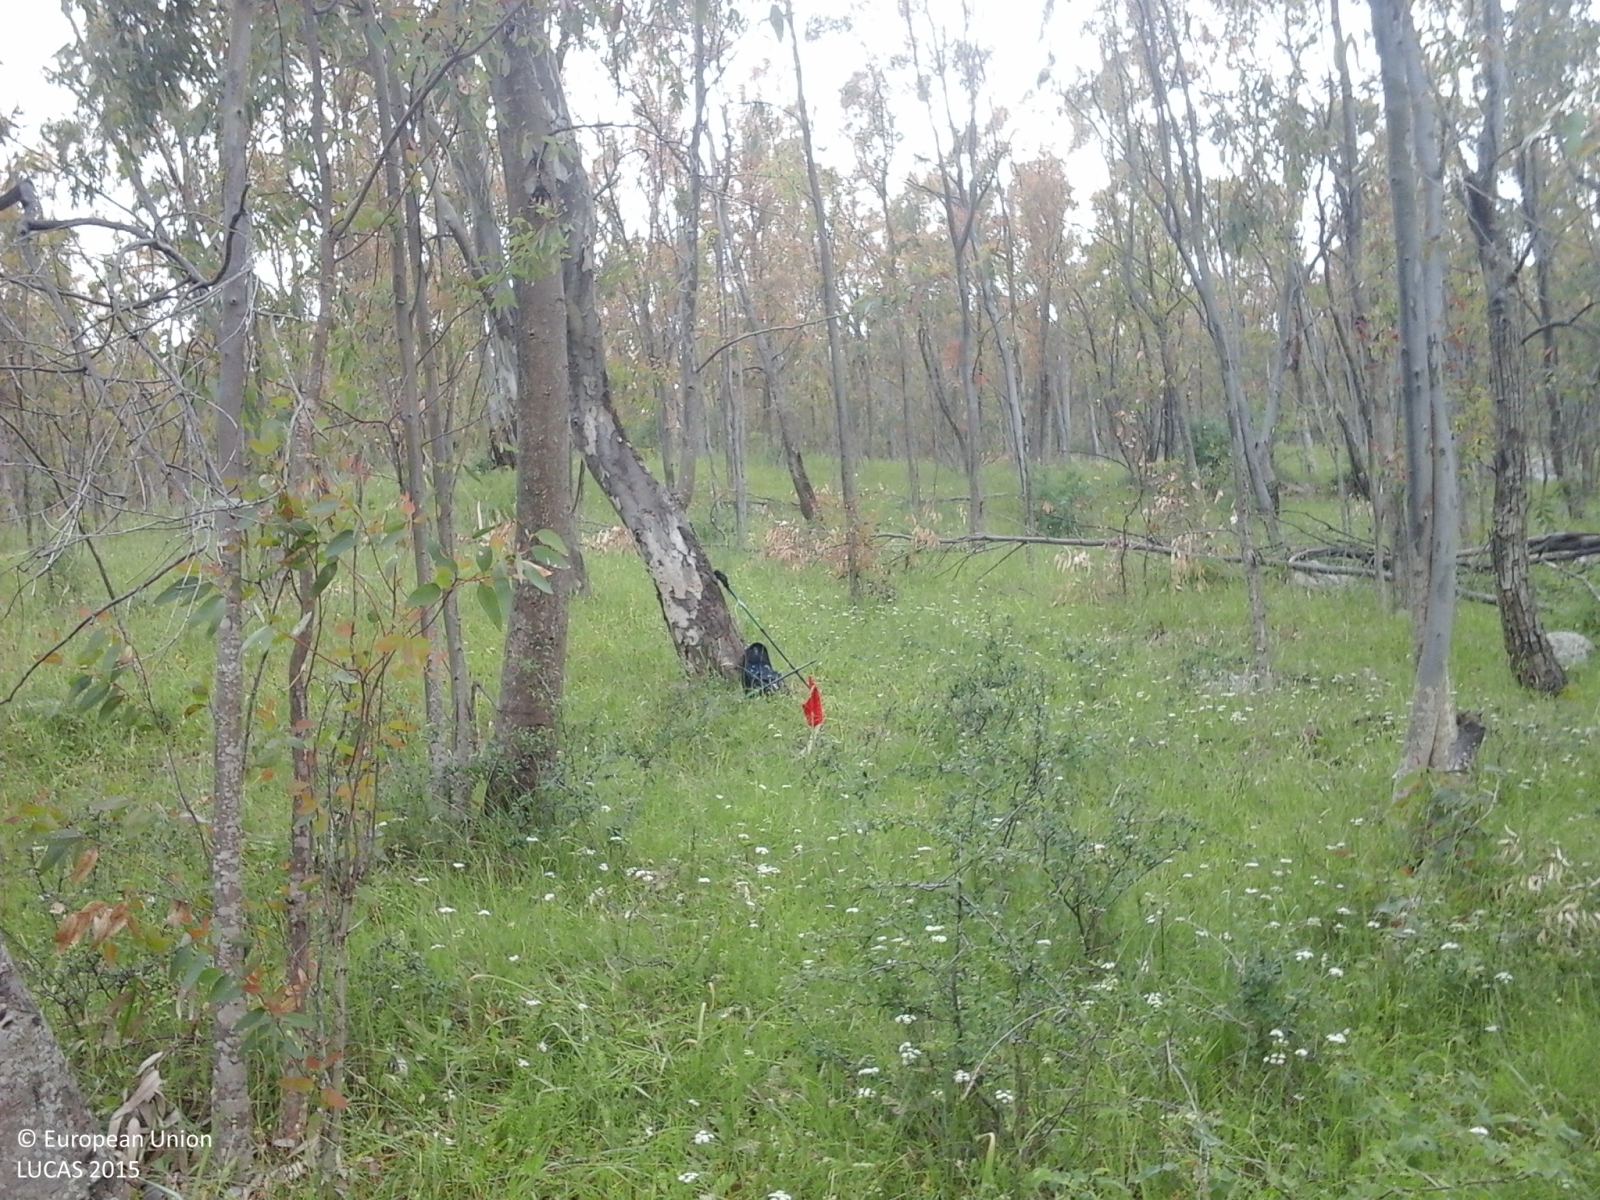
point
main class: Woodland
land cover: Broadleaved woodland
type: broadleaved evergreen forest
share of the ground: > 75 %
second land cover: Grassland without tree/shrub cover
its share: > 75 %
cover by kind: broadleaved forest trees 80 %, herbaceous plants 10 %, shrubs 5 %, consolidated bare surface 5 %
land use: Forestry
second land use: Agriculture (excluding fallow land and kitchen gardens)
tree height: > 5 m
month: May
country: IT
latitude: 37.8259
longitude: 14.4338
